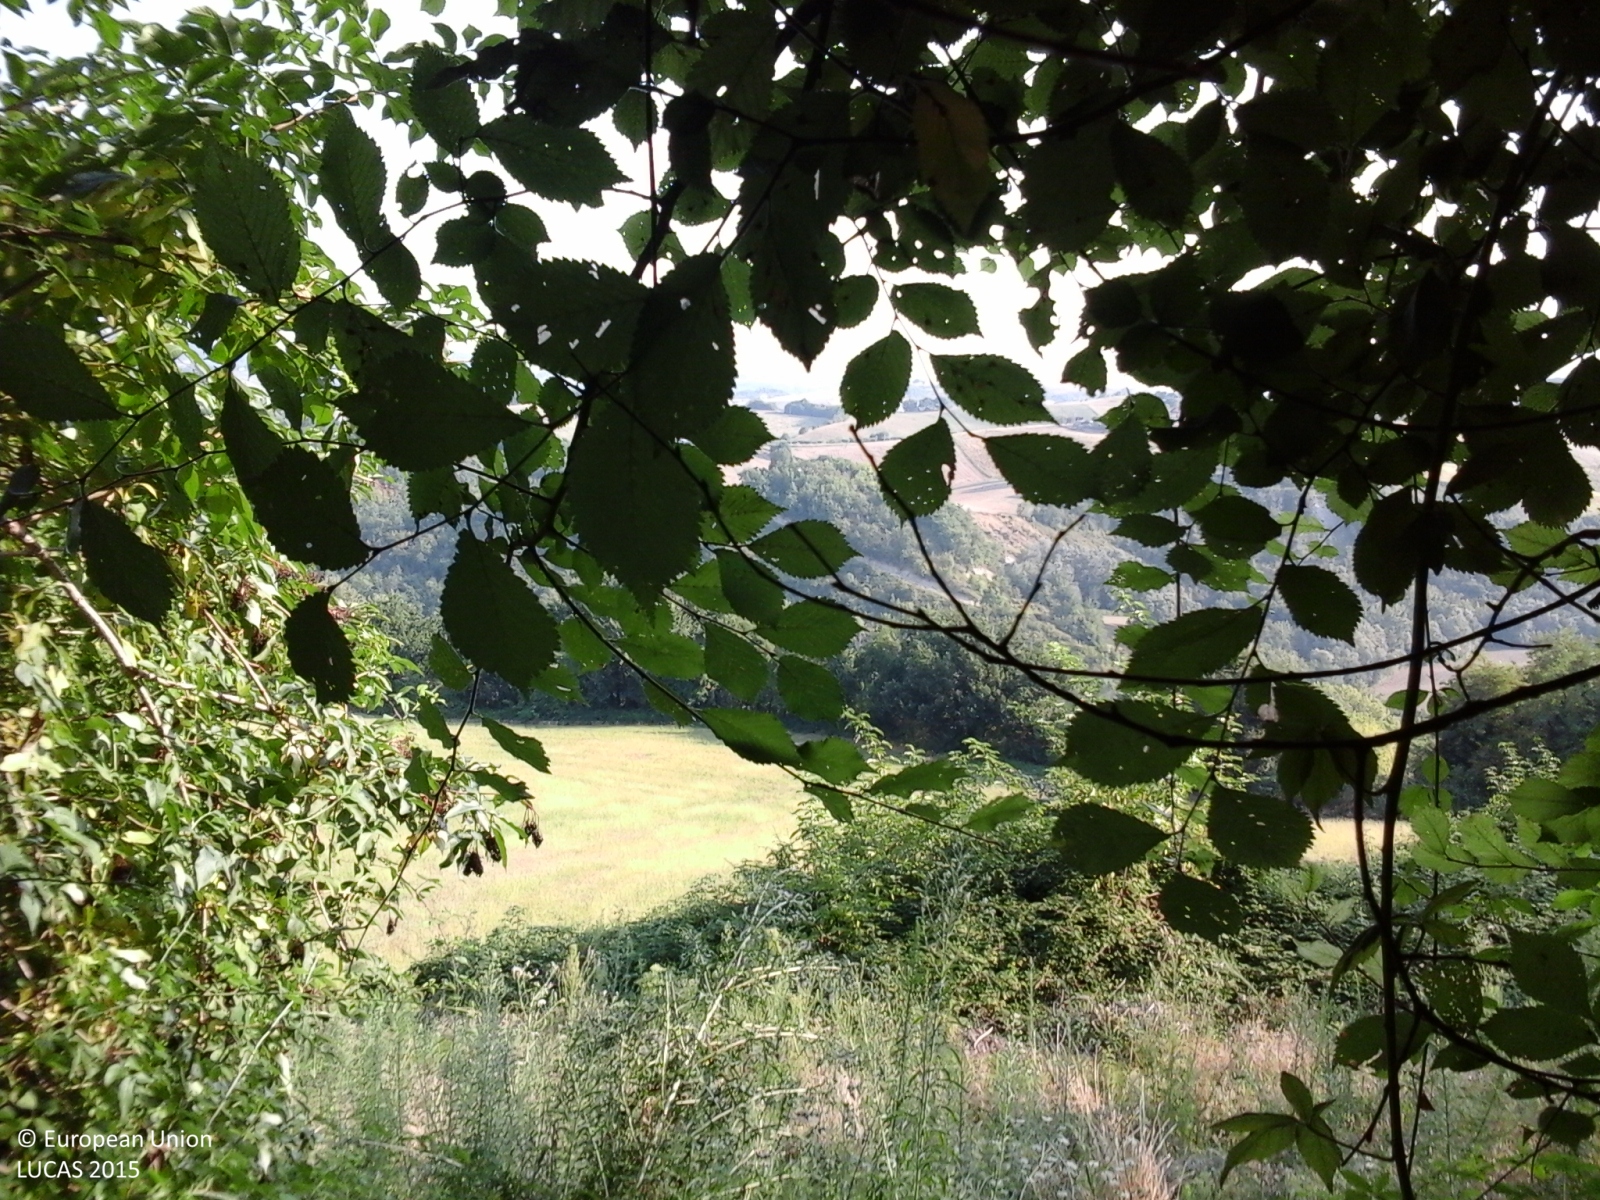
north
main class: Woodland
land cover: Broadleaved woodland
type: thermophilous deciduous forest
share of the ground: > 75 %
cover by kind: broadleaved forest trees 100 %
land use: Semi-natural and natural areas not in use
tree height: > 5 m
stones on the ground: < 10 %
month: August
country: IT
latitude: 43.1359
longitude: 13.4945
